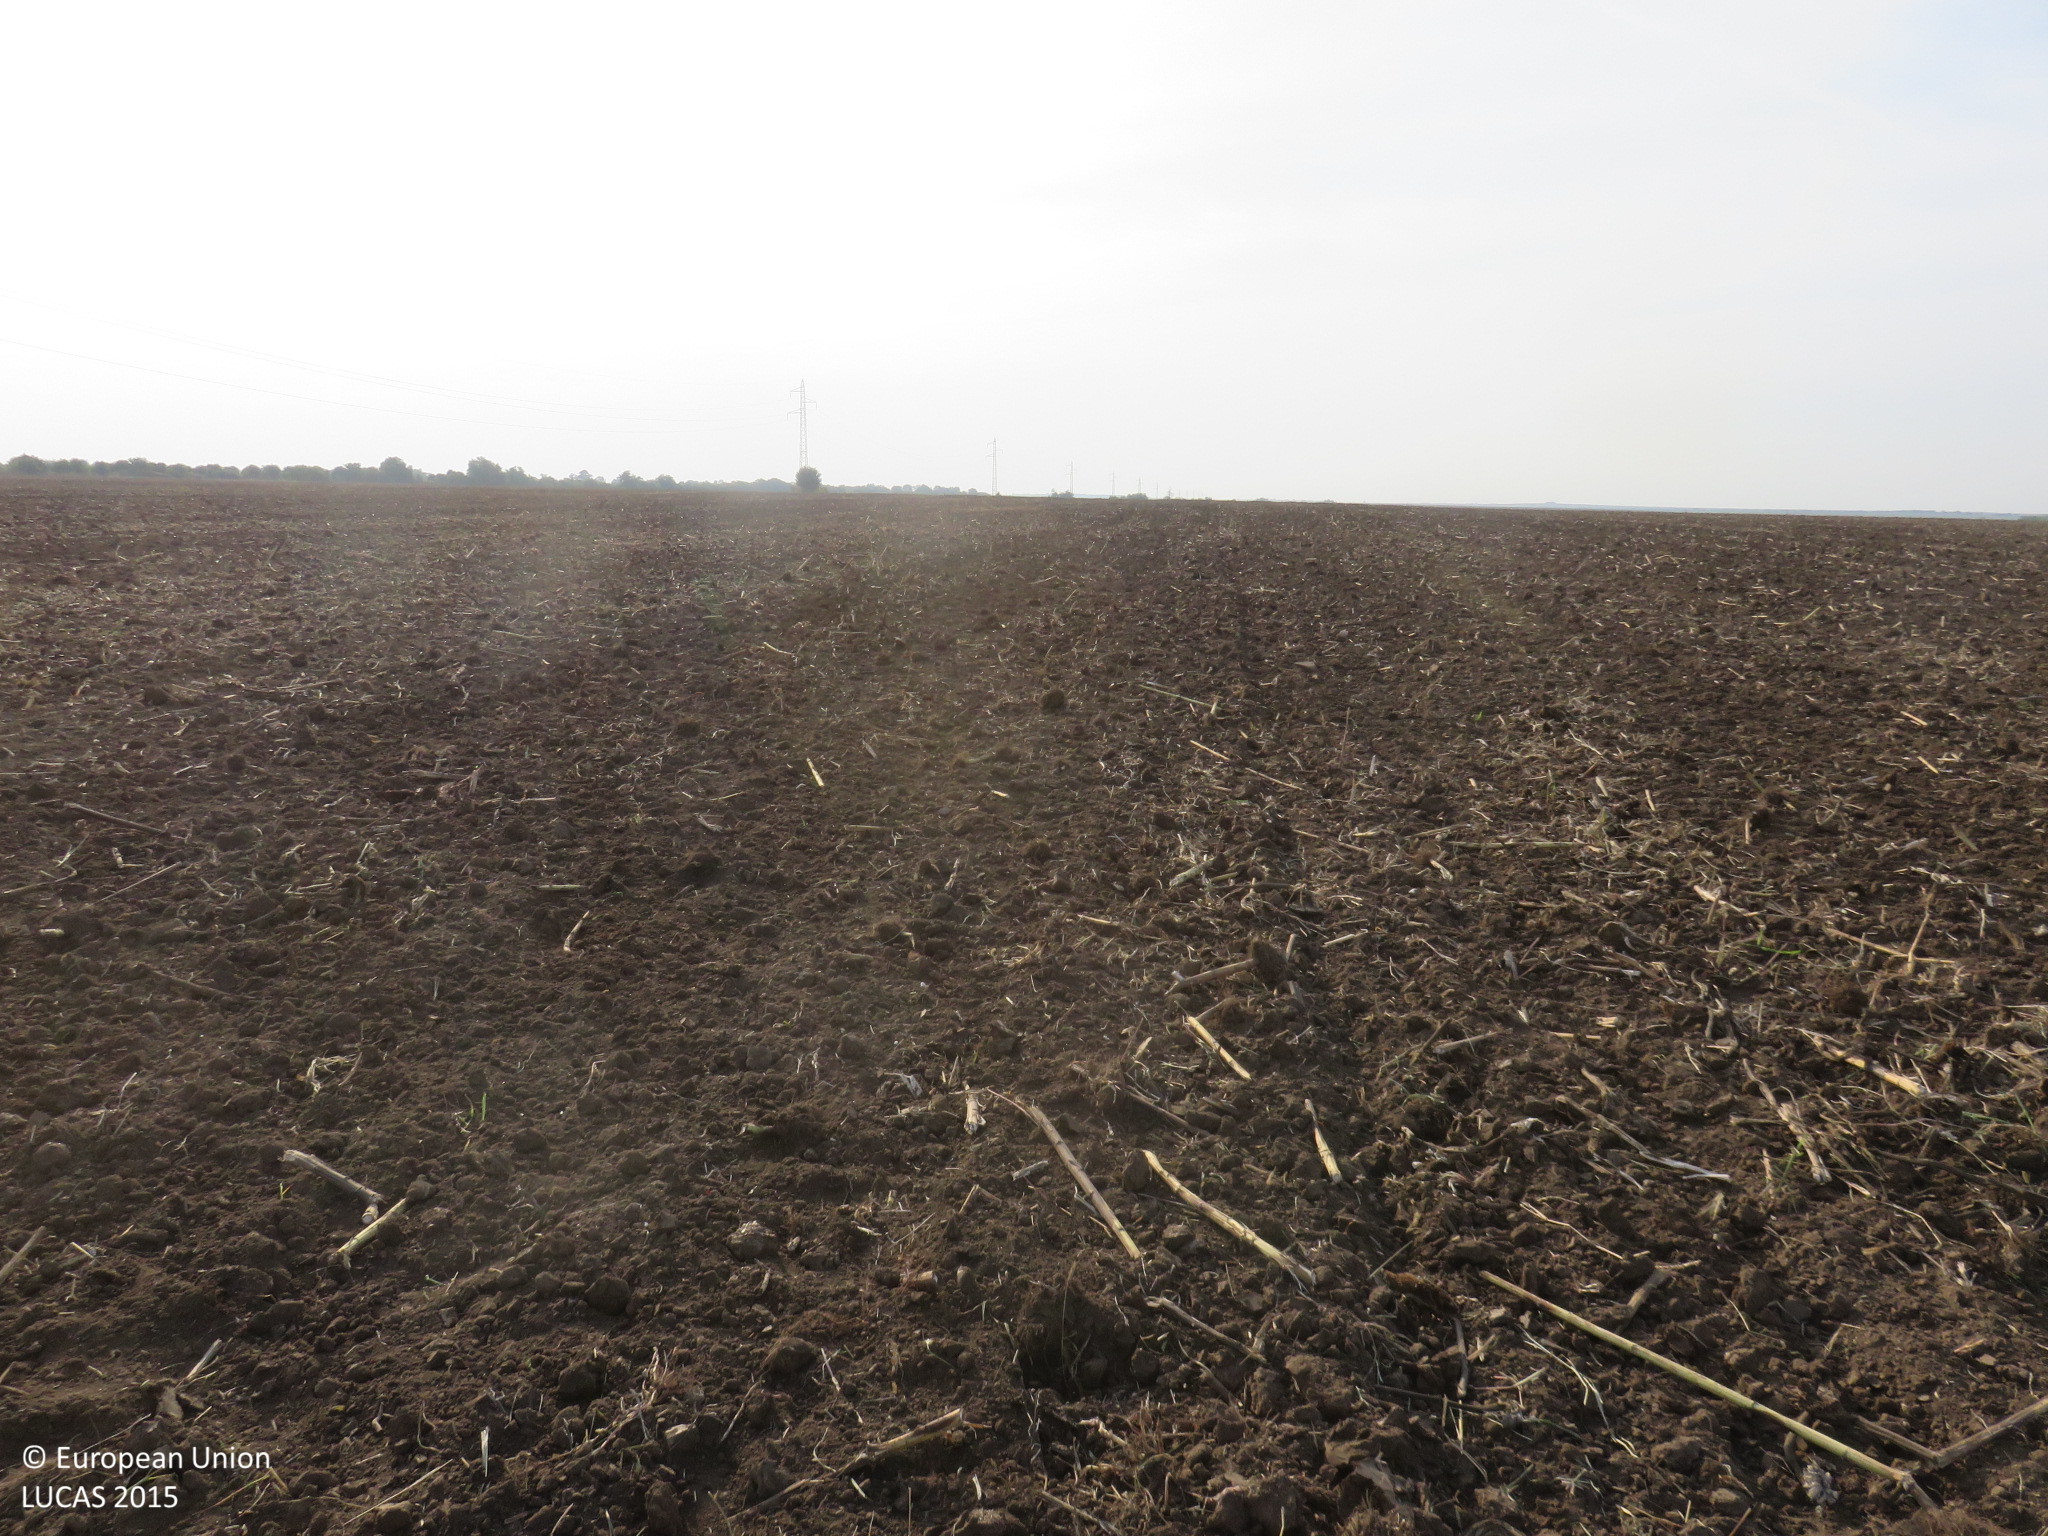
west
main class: Cropland
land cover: Sunflower
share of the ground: < 10 %
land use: Agriculture (excluding fallow land and kitchen gardens)
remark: Harvested field
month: September
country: BG
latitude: 43.3965
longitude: 24.8961
